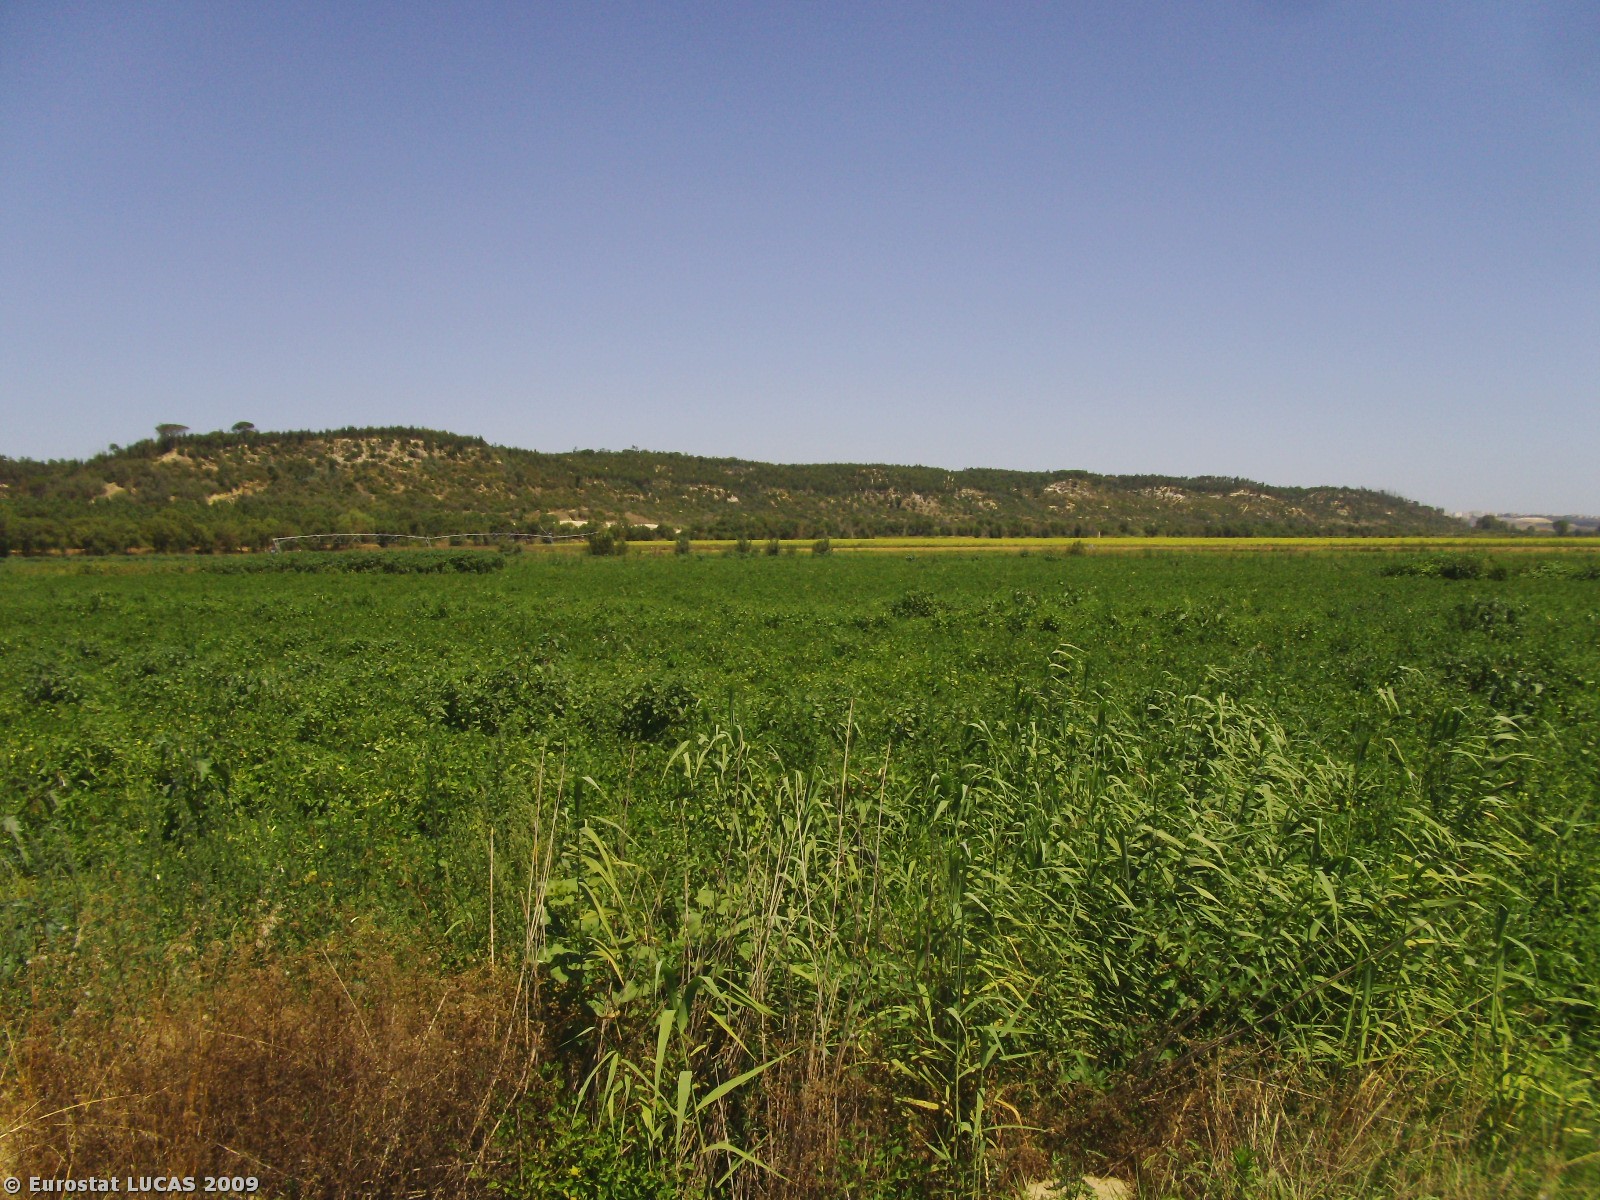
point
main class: Cropland
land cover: Tomatoes
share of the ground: > 75 %
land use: Agriculture (excluding fallow land and kitchen gardens)
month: July
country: PT
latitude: 39.1651
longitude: -8.7410
